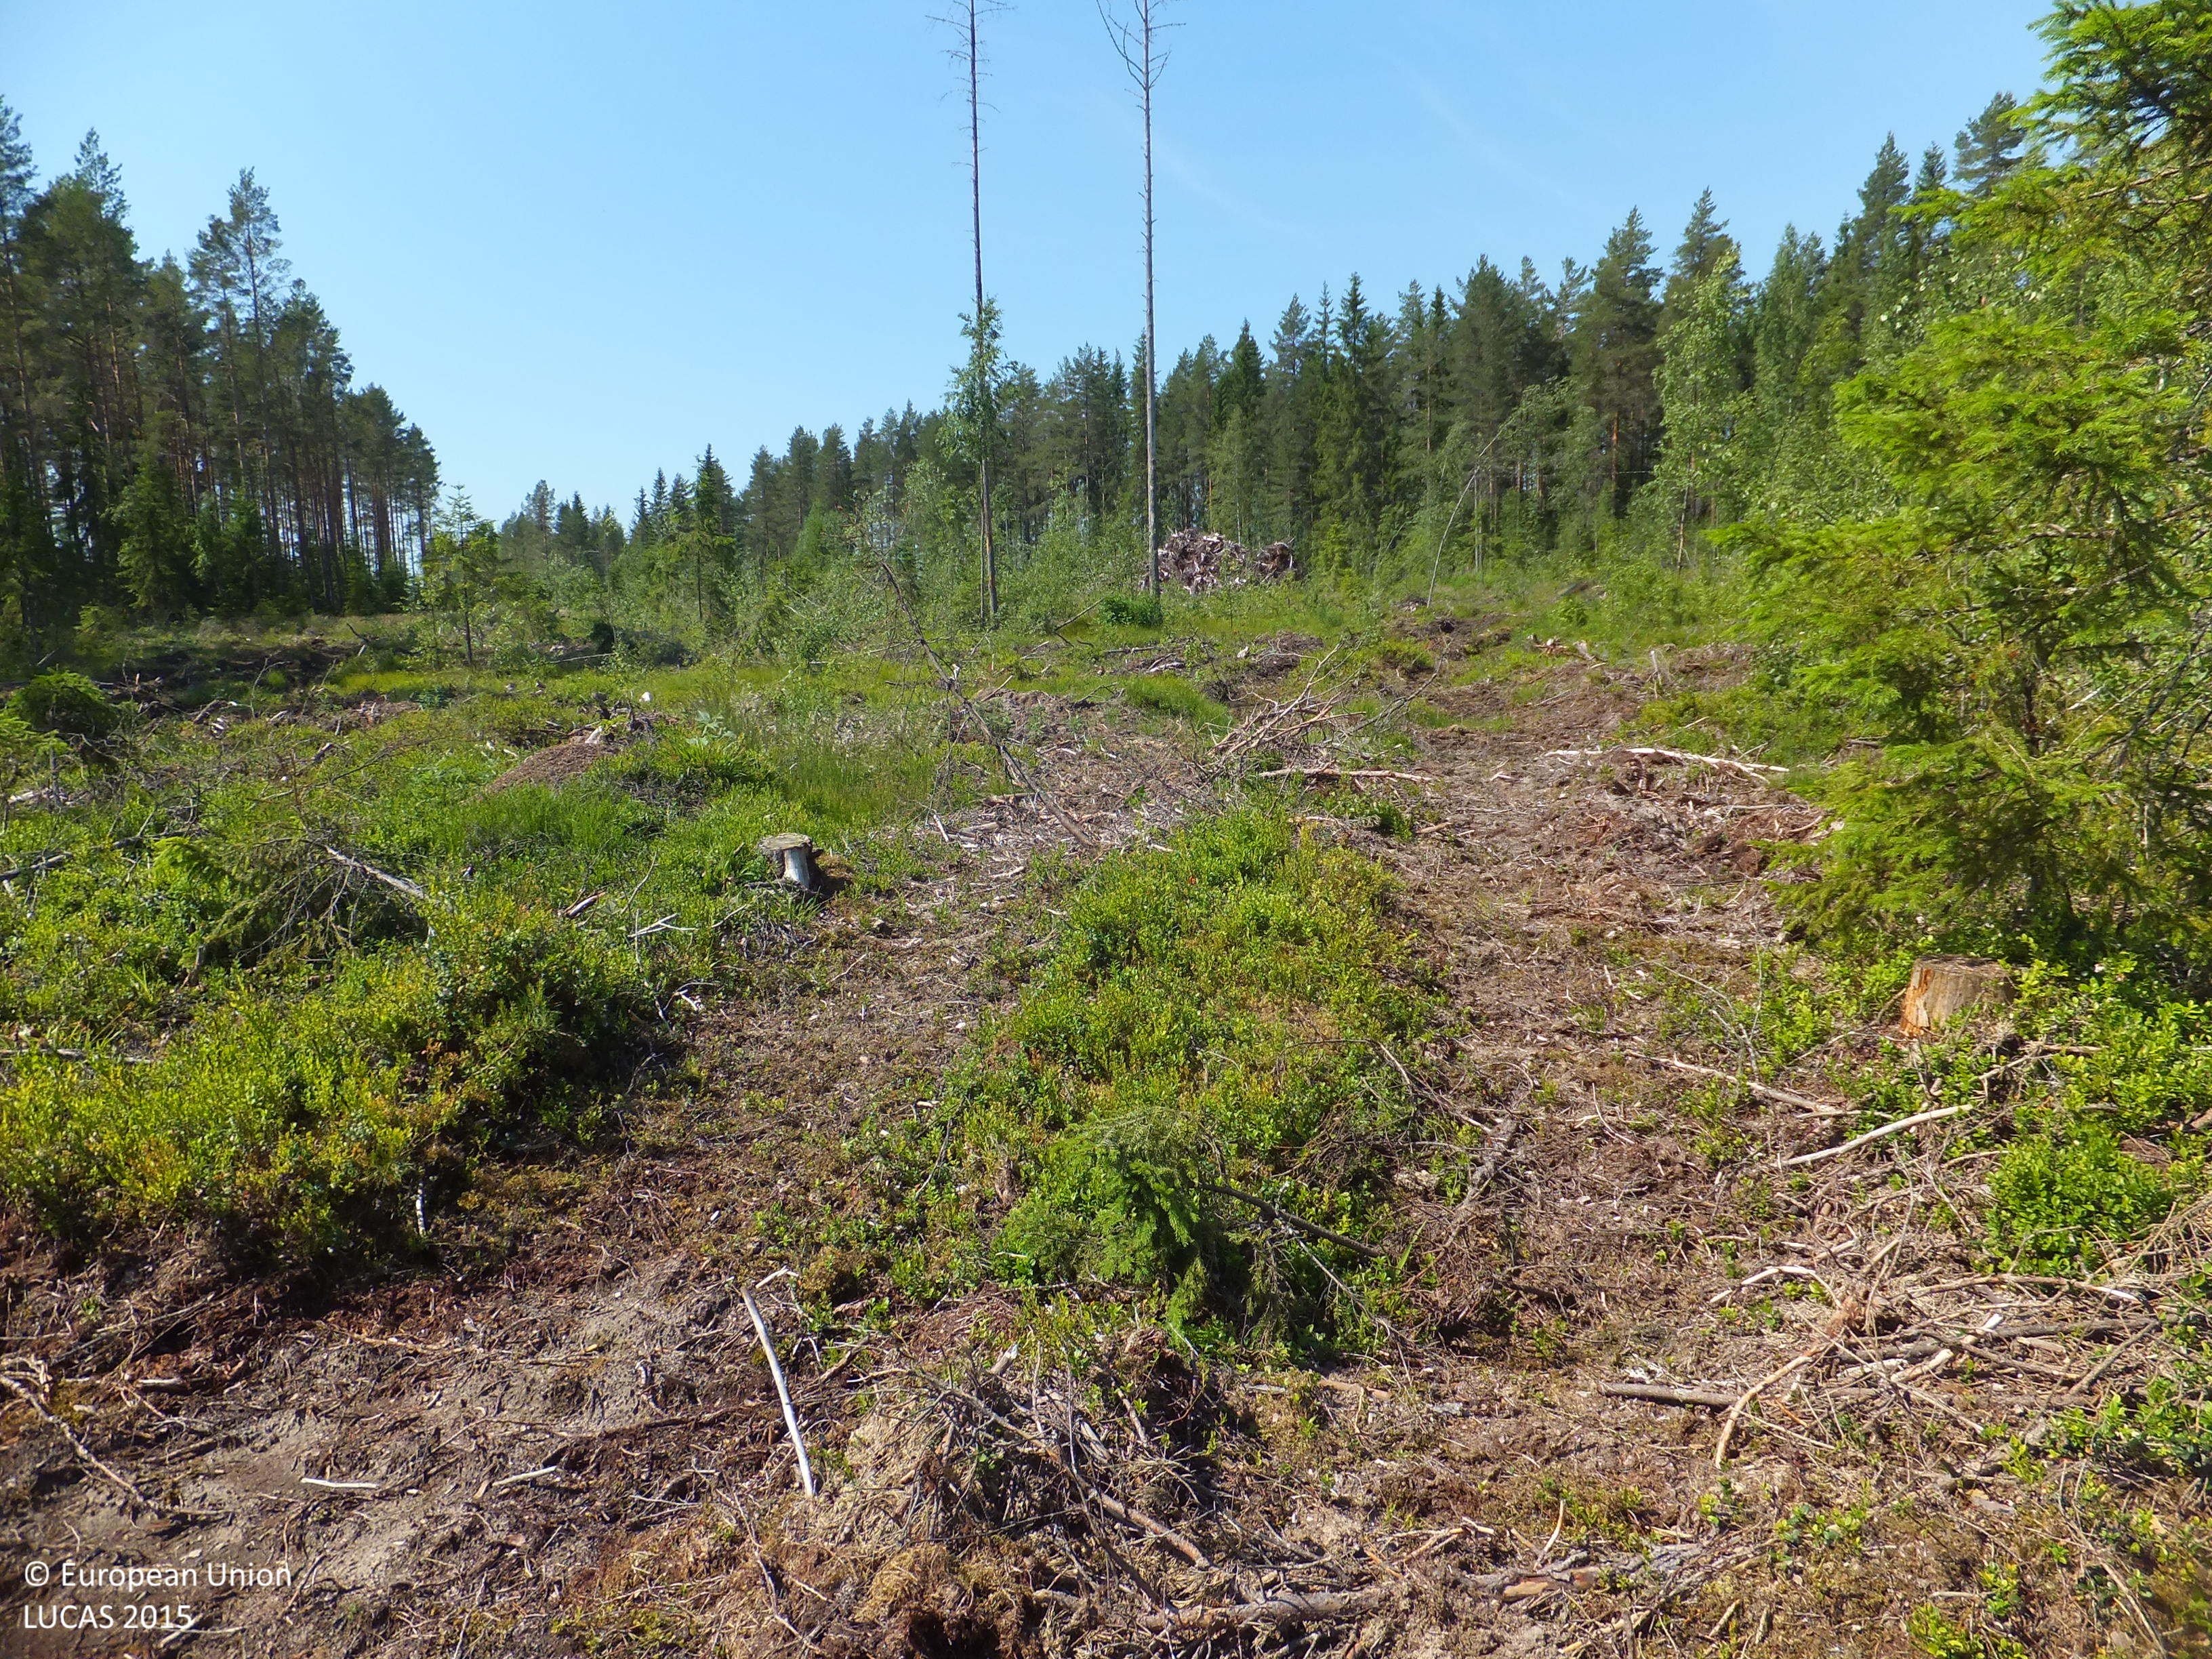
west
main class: Shrubland
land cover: Shrubland with sparse tree cover
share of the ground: 50 - 75 %
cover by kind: shrubs 45 %, herbaceous plants 20 %, unconsolidated bare surface 15 %, coniferous forest trees 5 %, lichens and mosses 5 %
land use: Forestry
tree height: < 5 m
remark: Clear cut
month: July
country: FI
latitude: 63.2026
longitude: 23.8081
